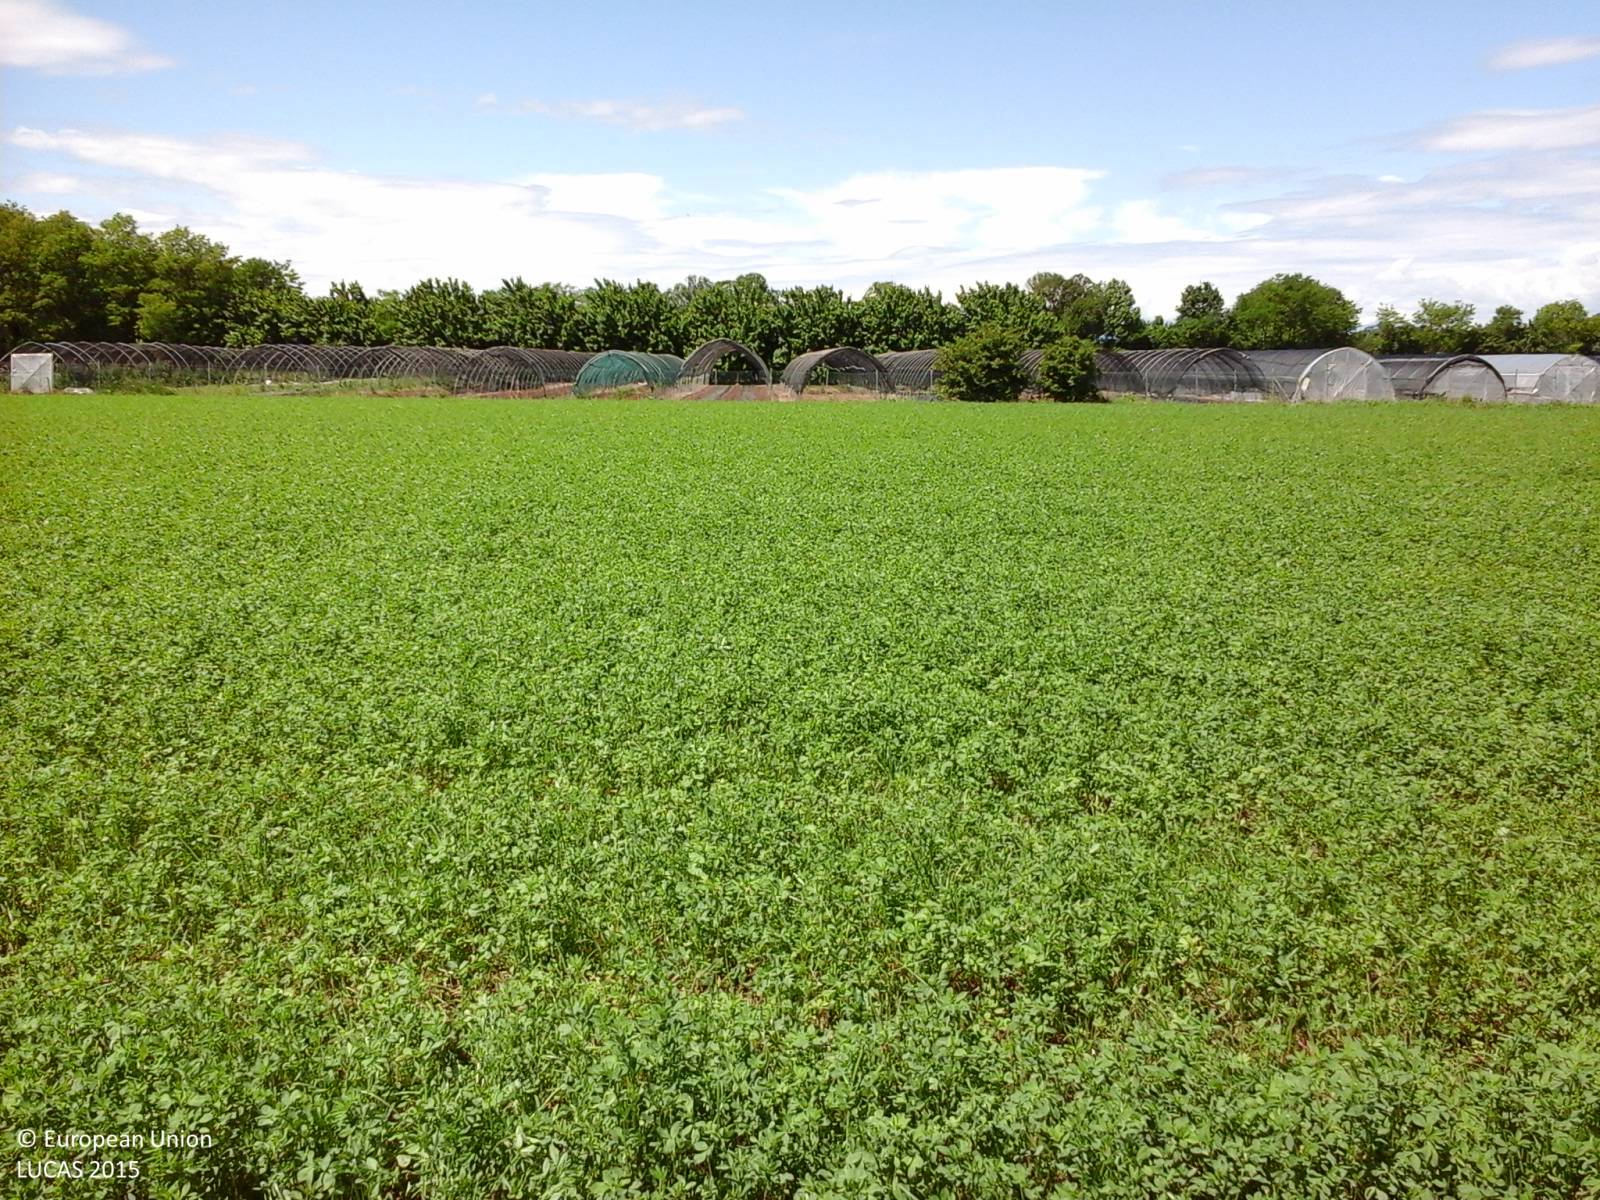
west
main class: Cropland
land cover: Lucerne
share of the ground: > 75 %
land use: Agriculture (excluding fallow land and kitchen gardens)
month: May
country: IT
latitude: 46.0889
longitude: 13.1392
